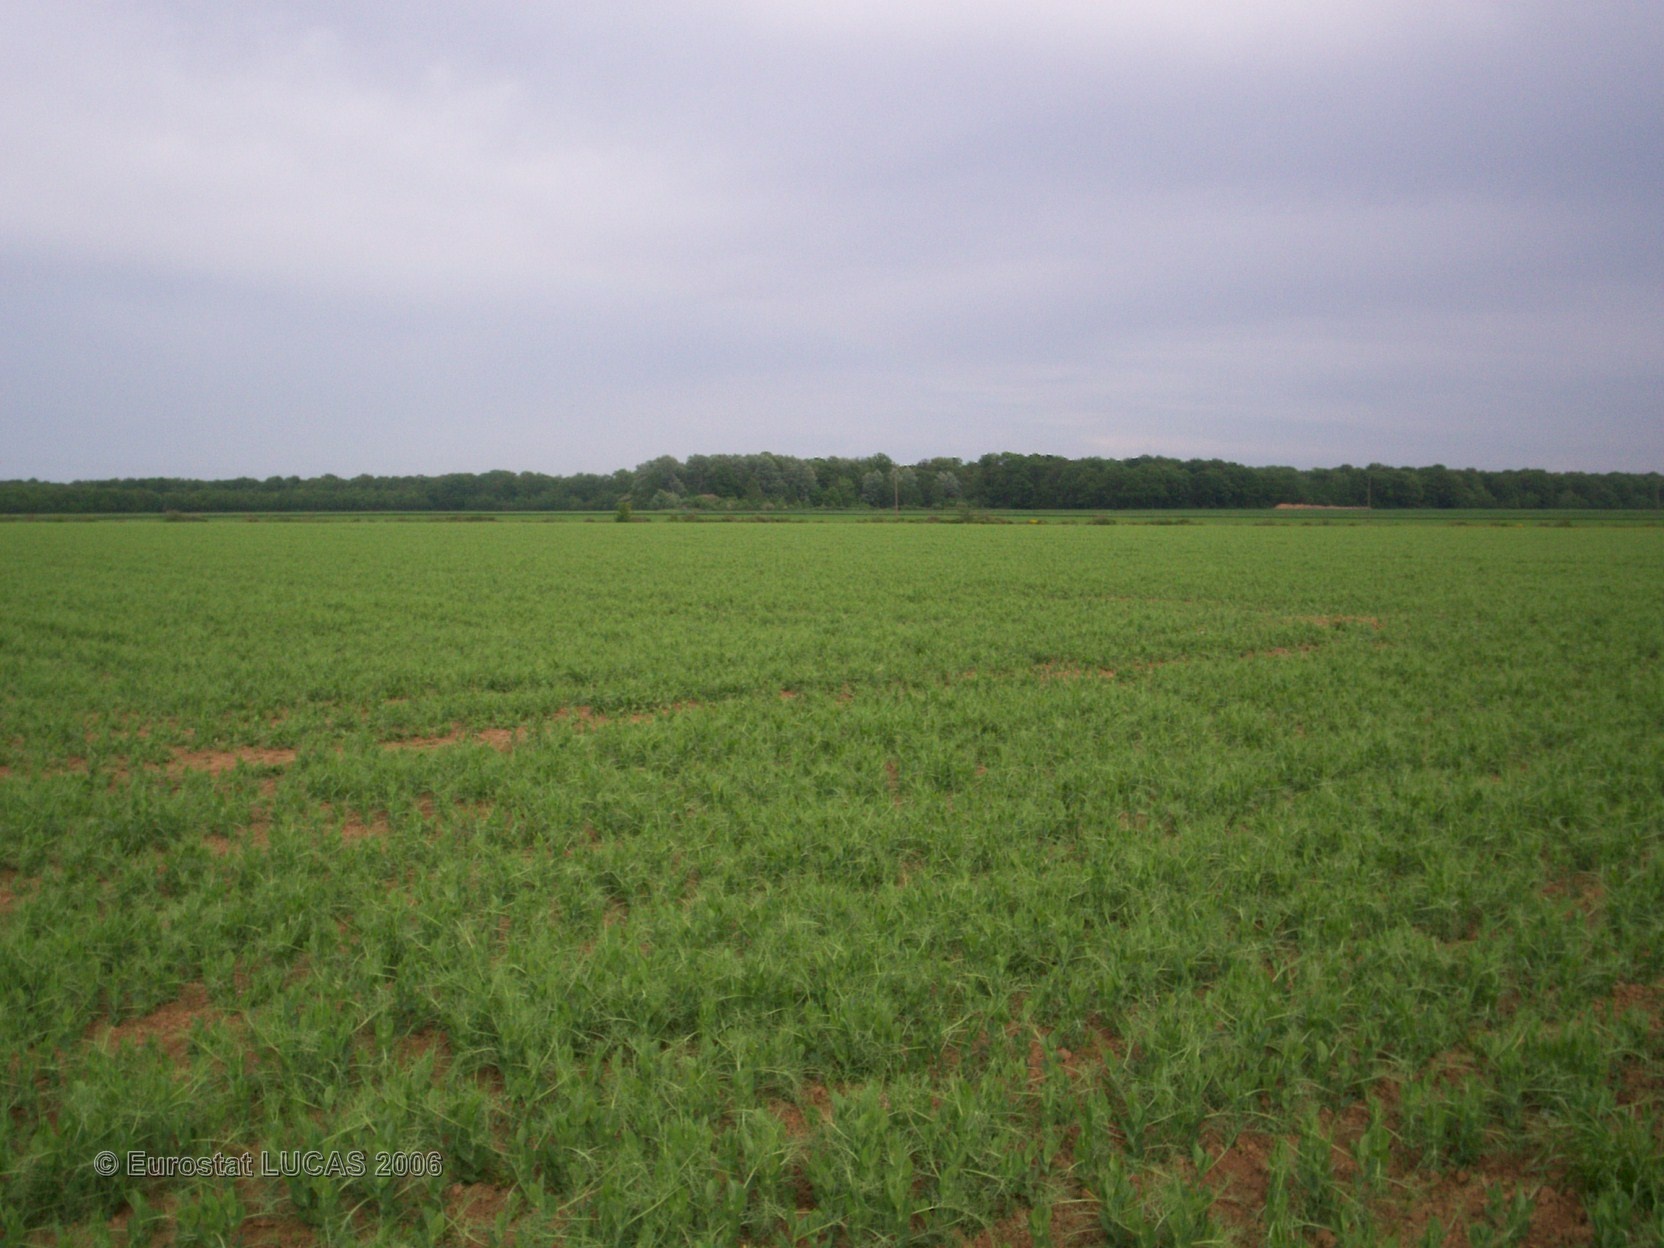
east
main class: Cropland
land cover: Dry pulses
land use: Agriculture (excluding fallow land and kitchen gardens)
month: May
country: FR
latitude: 48.6910
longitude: 2.7769
